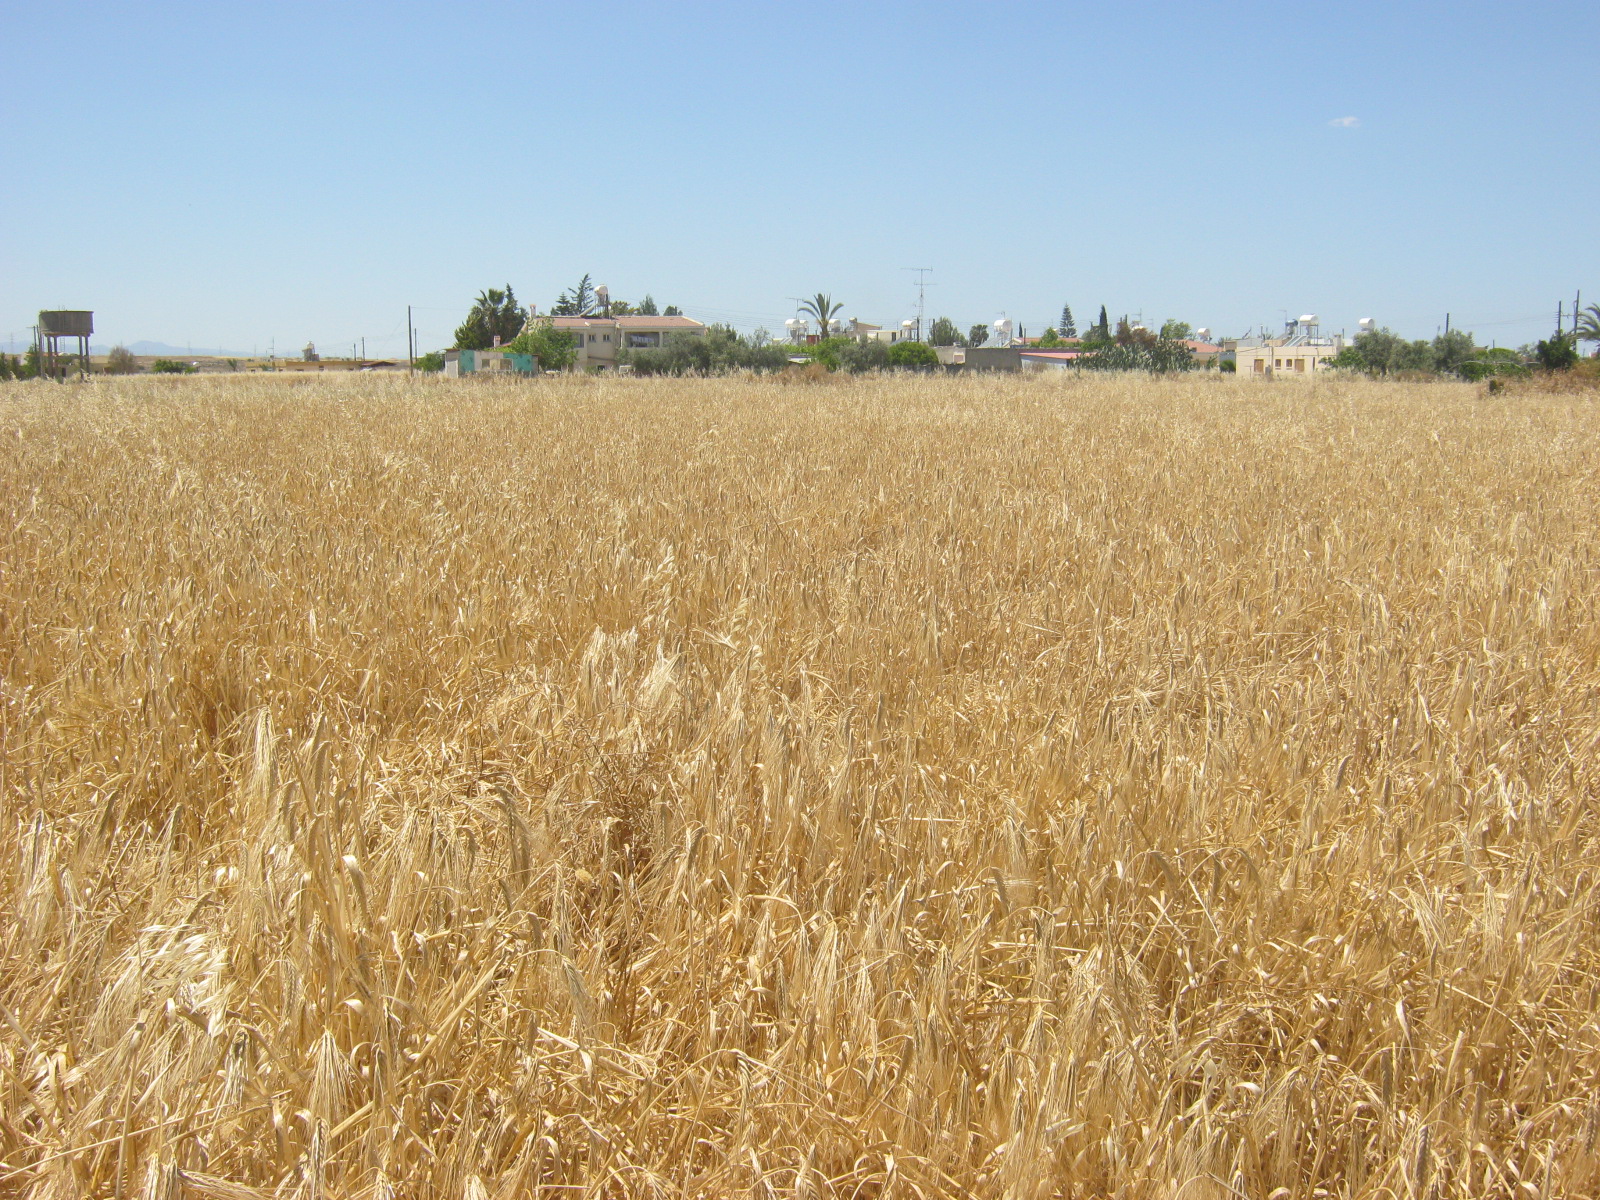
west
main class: Cropland
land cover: Barley
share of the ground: > 75 %
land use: Agriculture (excluding fallow land and kitchen gardens)
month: May
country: CY
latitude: 35.1136
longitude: 33.2163
